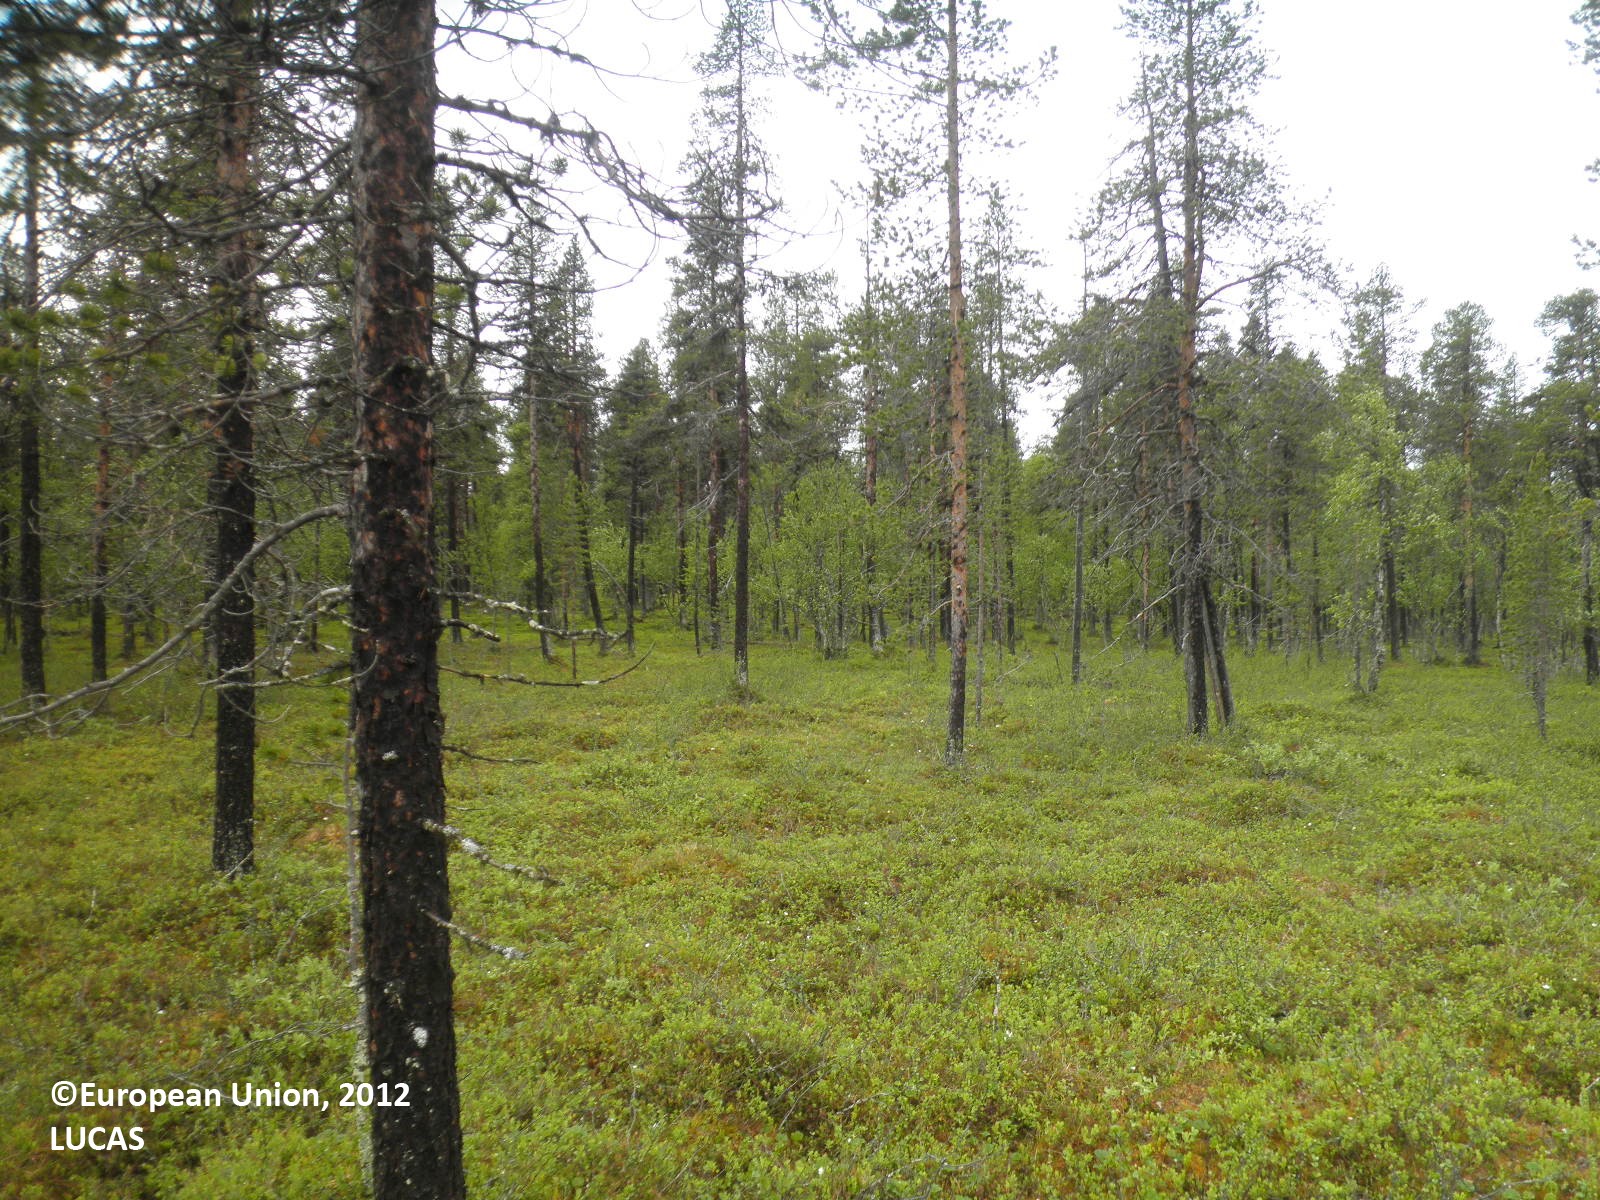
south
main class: Woodland
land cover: Pine dominated coniferous woodland
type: boreal forest
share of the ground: 10 - 25 %
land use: Forestry
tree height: > 5 m
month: June
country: FI
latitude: 68.3992
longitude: 26.4859
